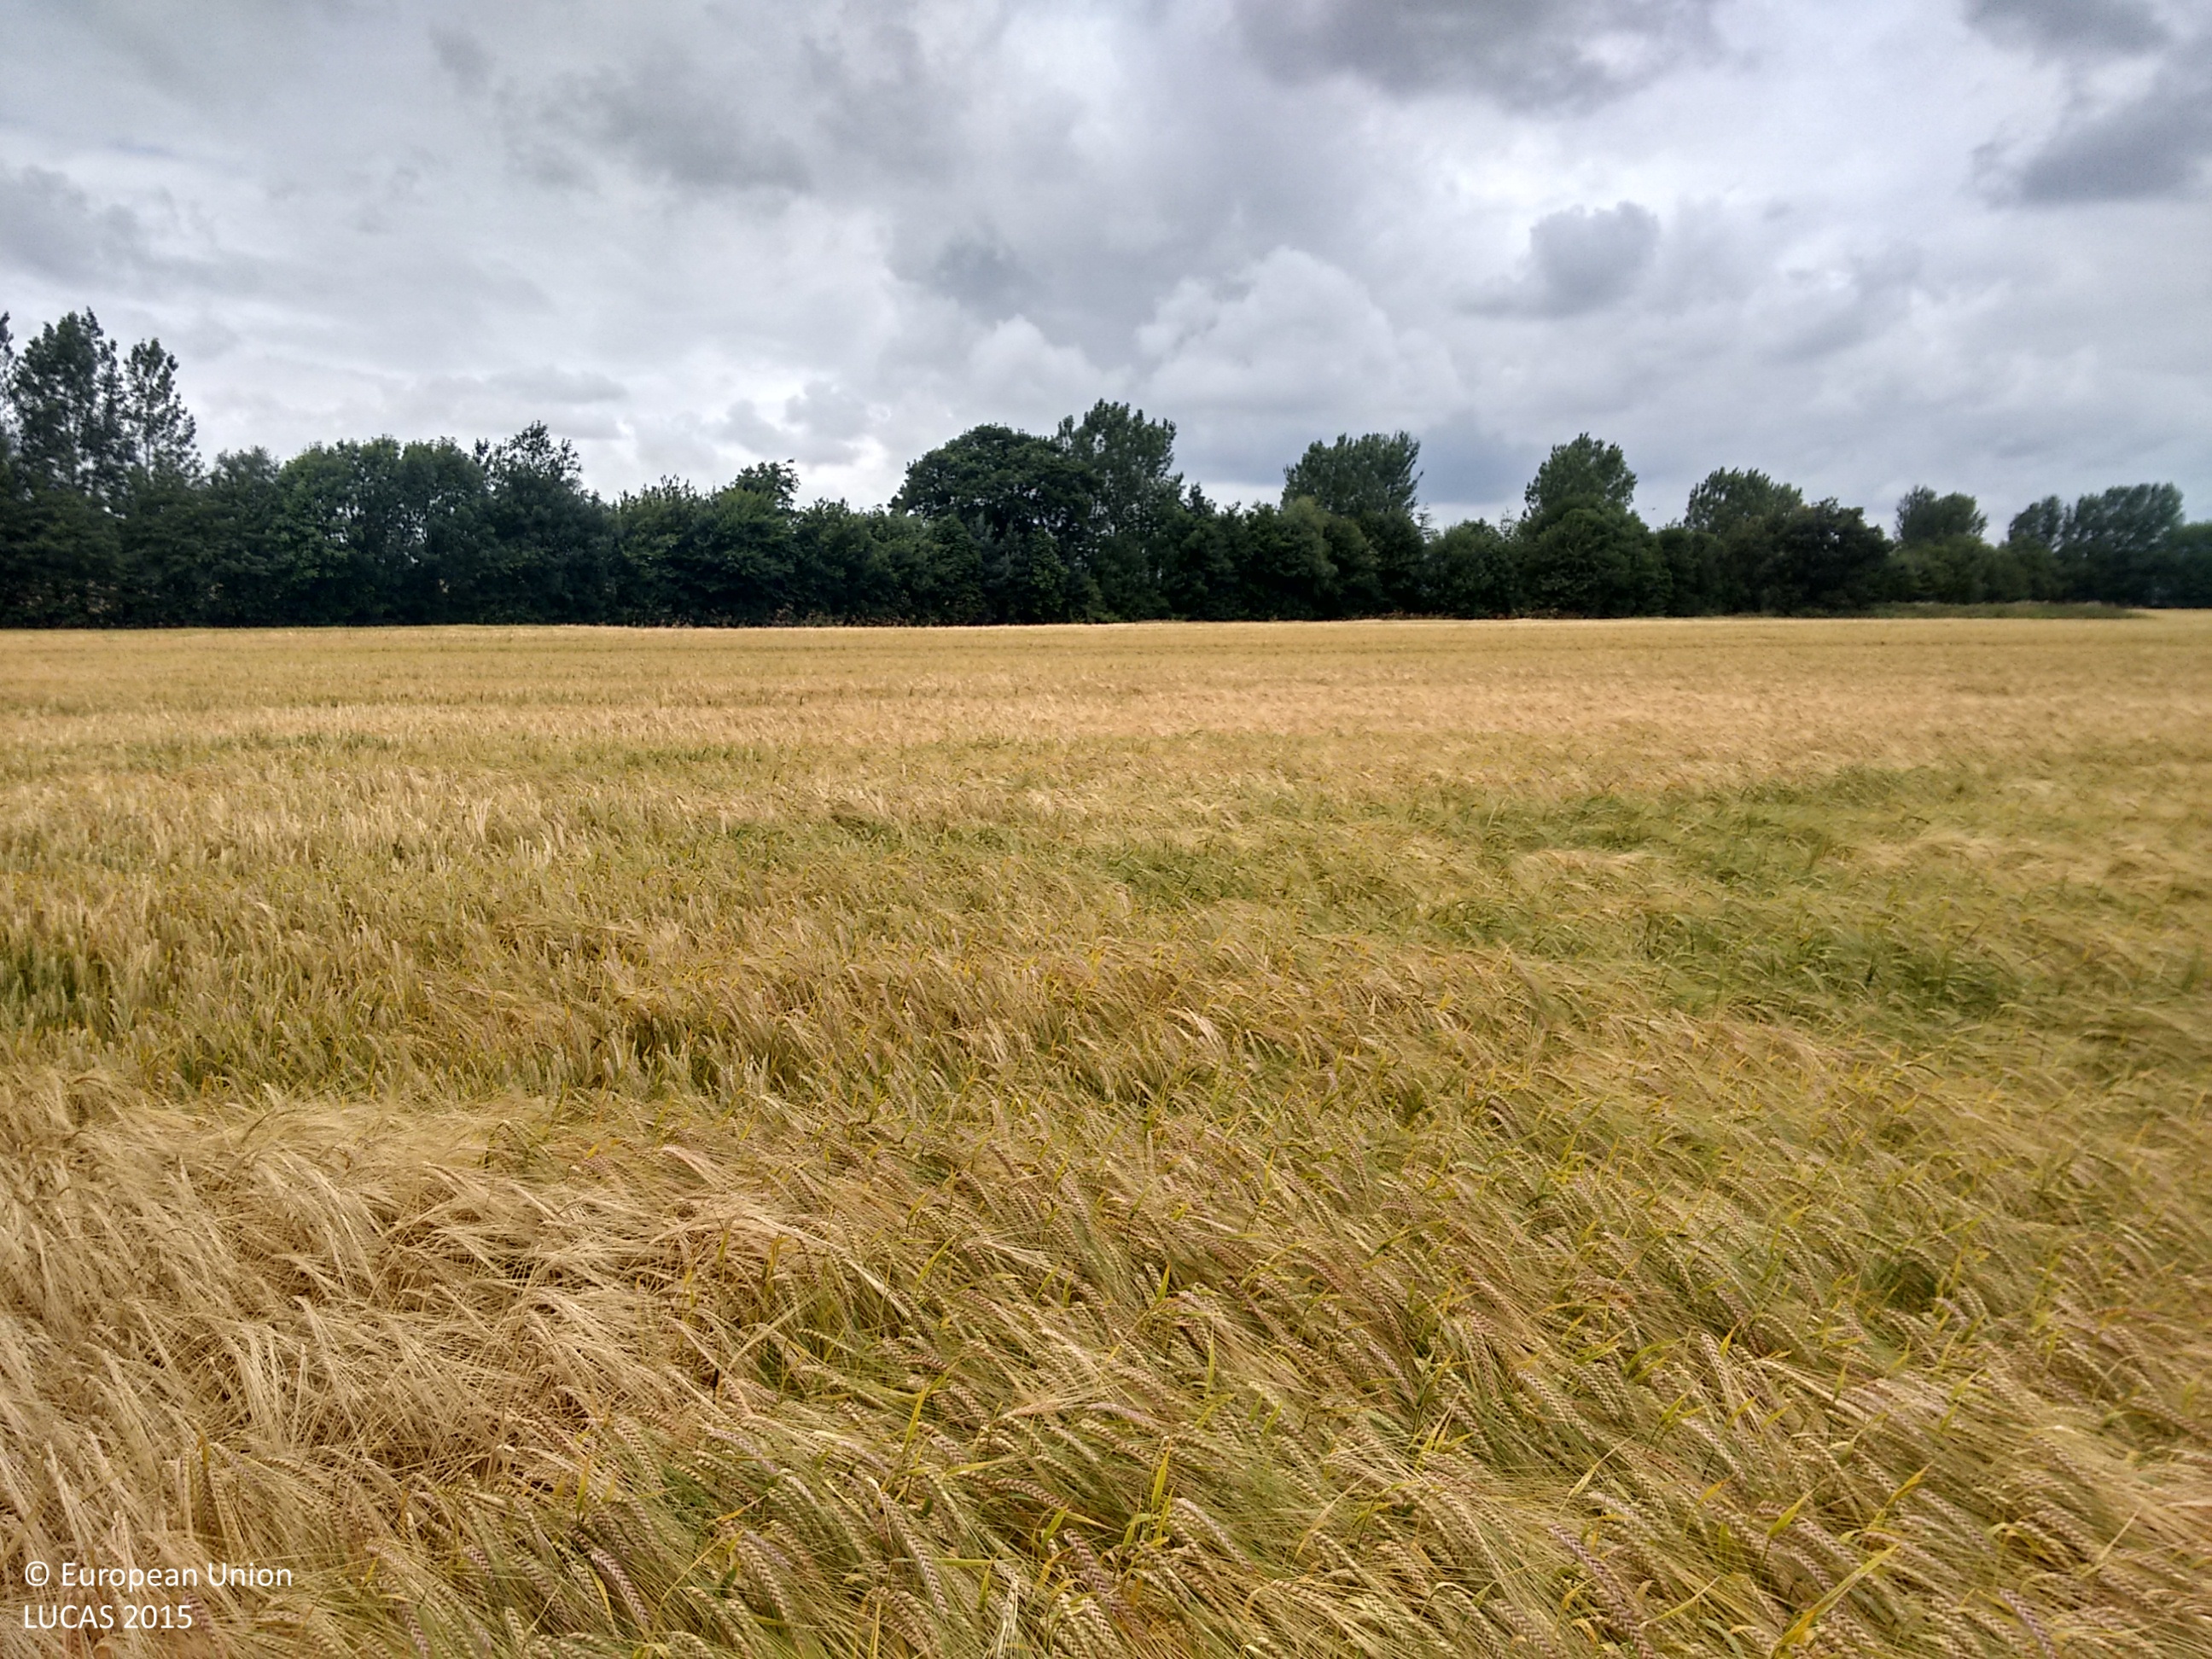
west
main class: Cropland
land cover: Barley
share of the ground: > 75 %
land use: Agriculture (excluding fallow land and kitchen gardens)
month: July
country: GB
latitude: 52.8781
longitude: -1.4165
